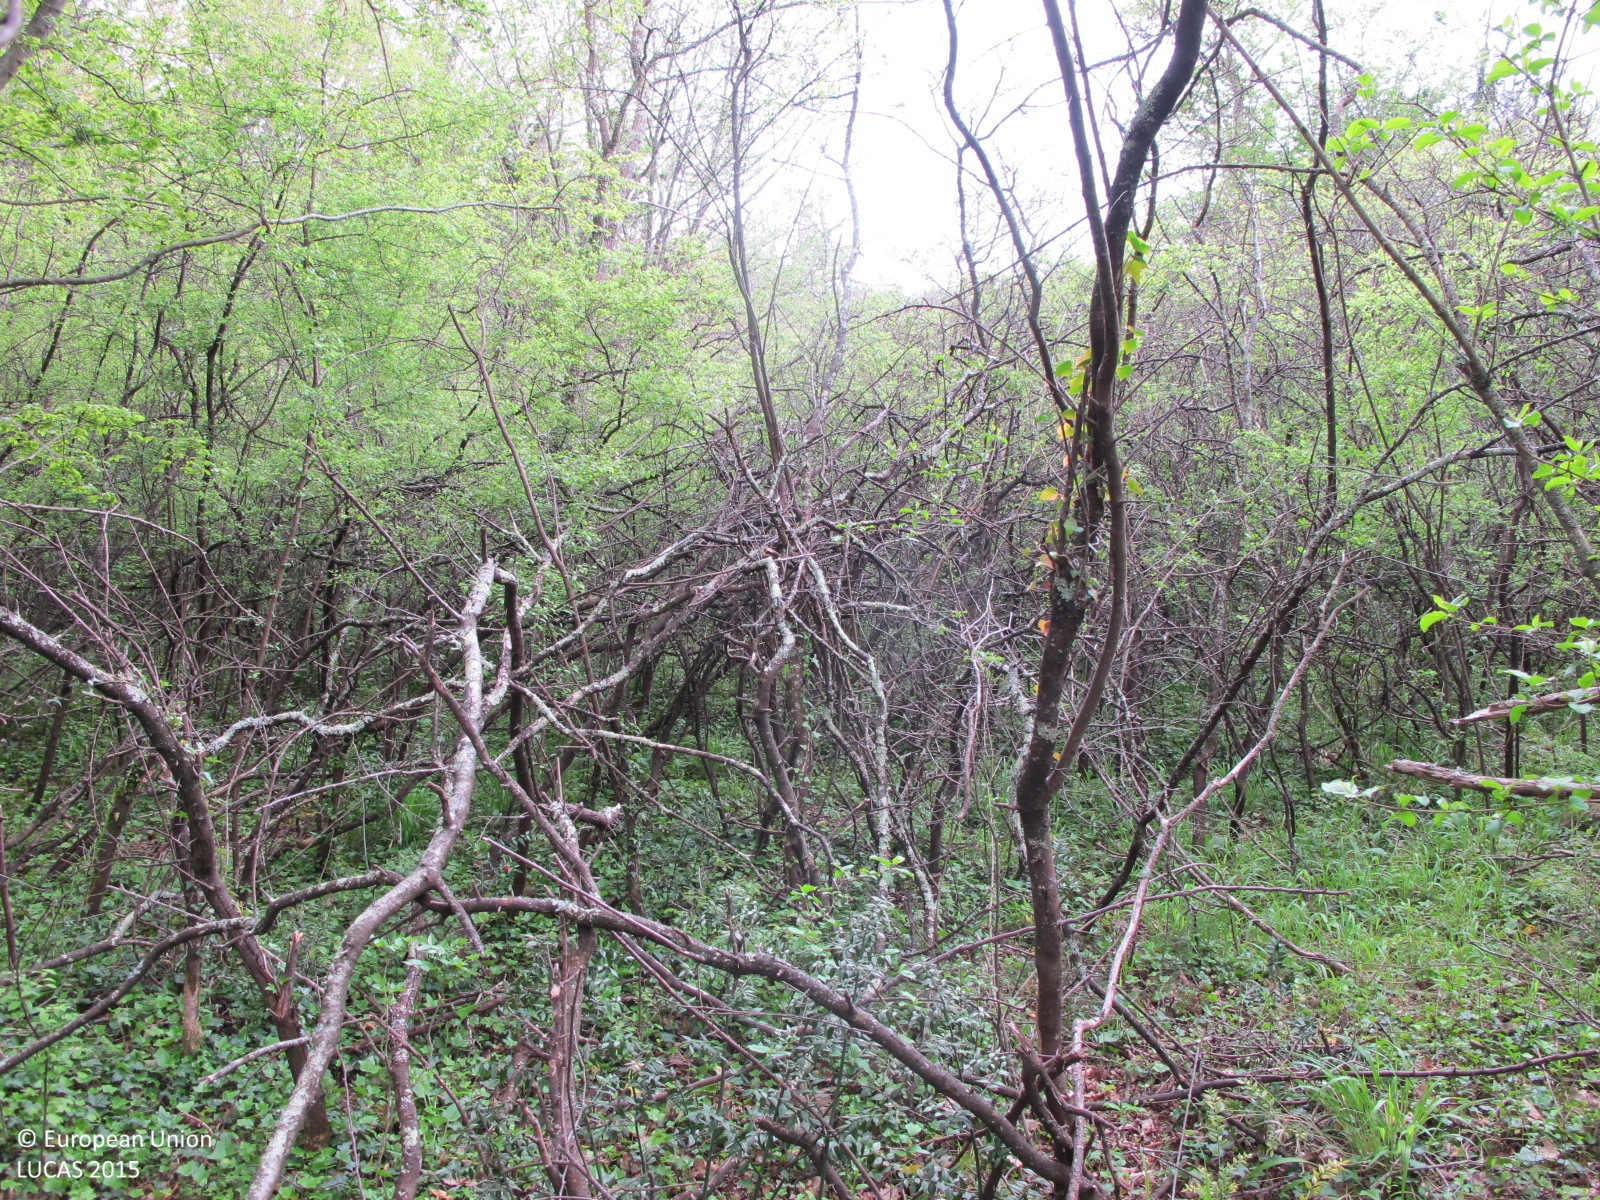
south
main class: Woodland
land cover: Broadleaved woodland
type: thermophilous deciduous forest
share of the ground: > 75 %
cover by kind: broadleaved forest trees 70 %, shrubs 15 %, herbaceous plants 5 %
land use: Semi-natural and natural areas not in use
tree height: > 5 m
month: April
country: HR
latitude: 45.2229
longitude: 14.6177
